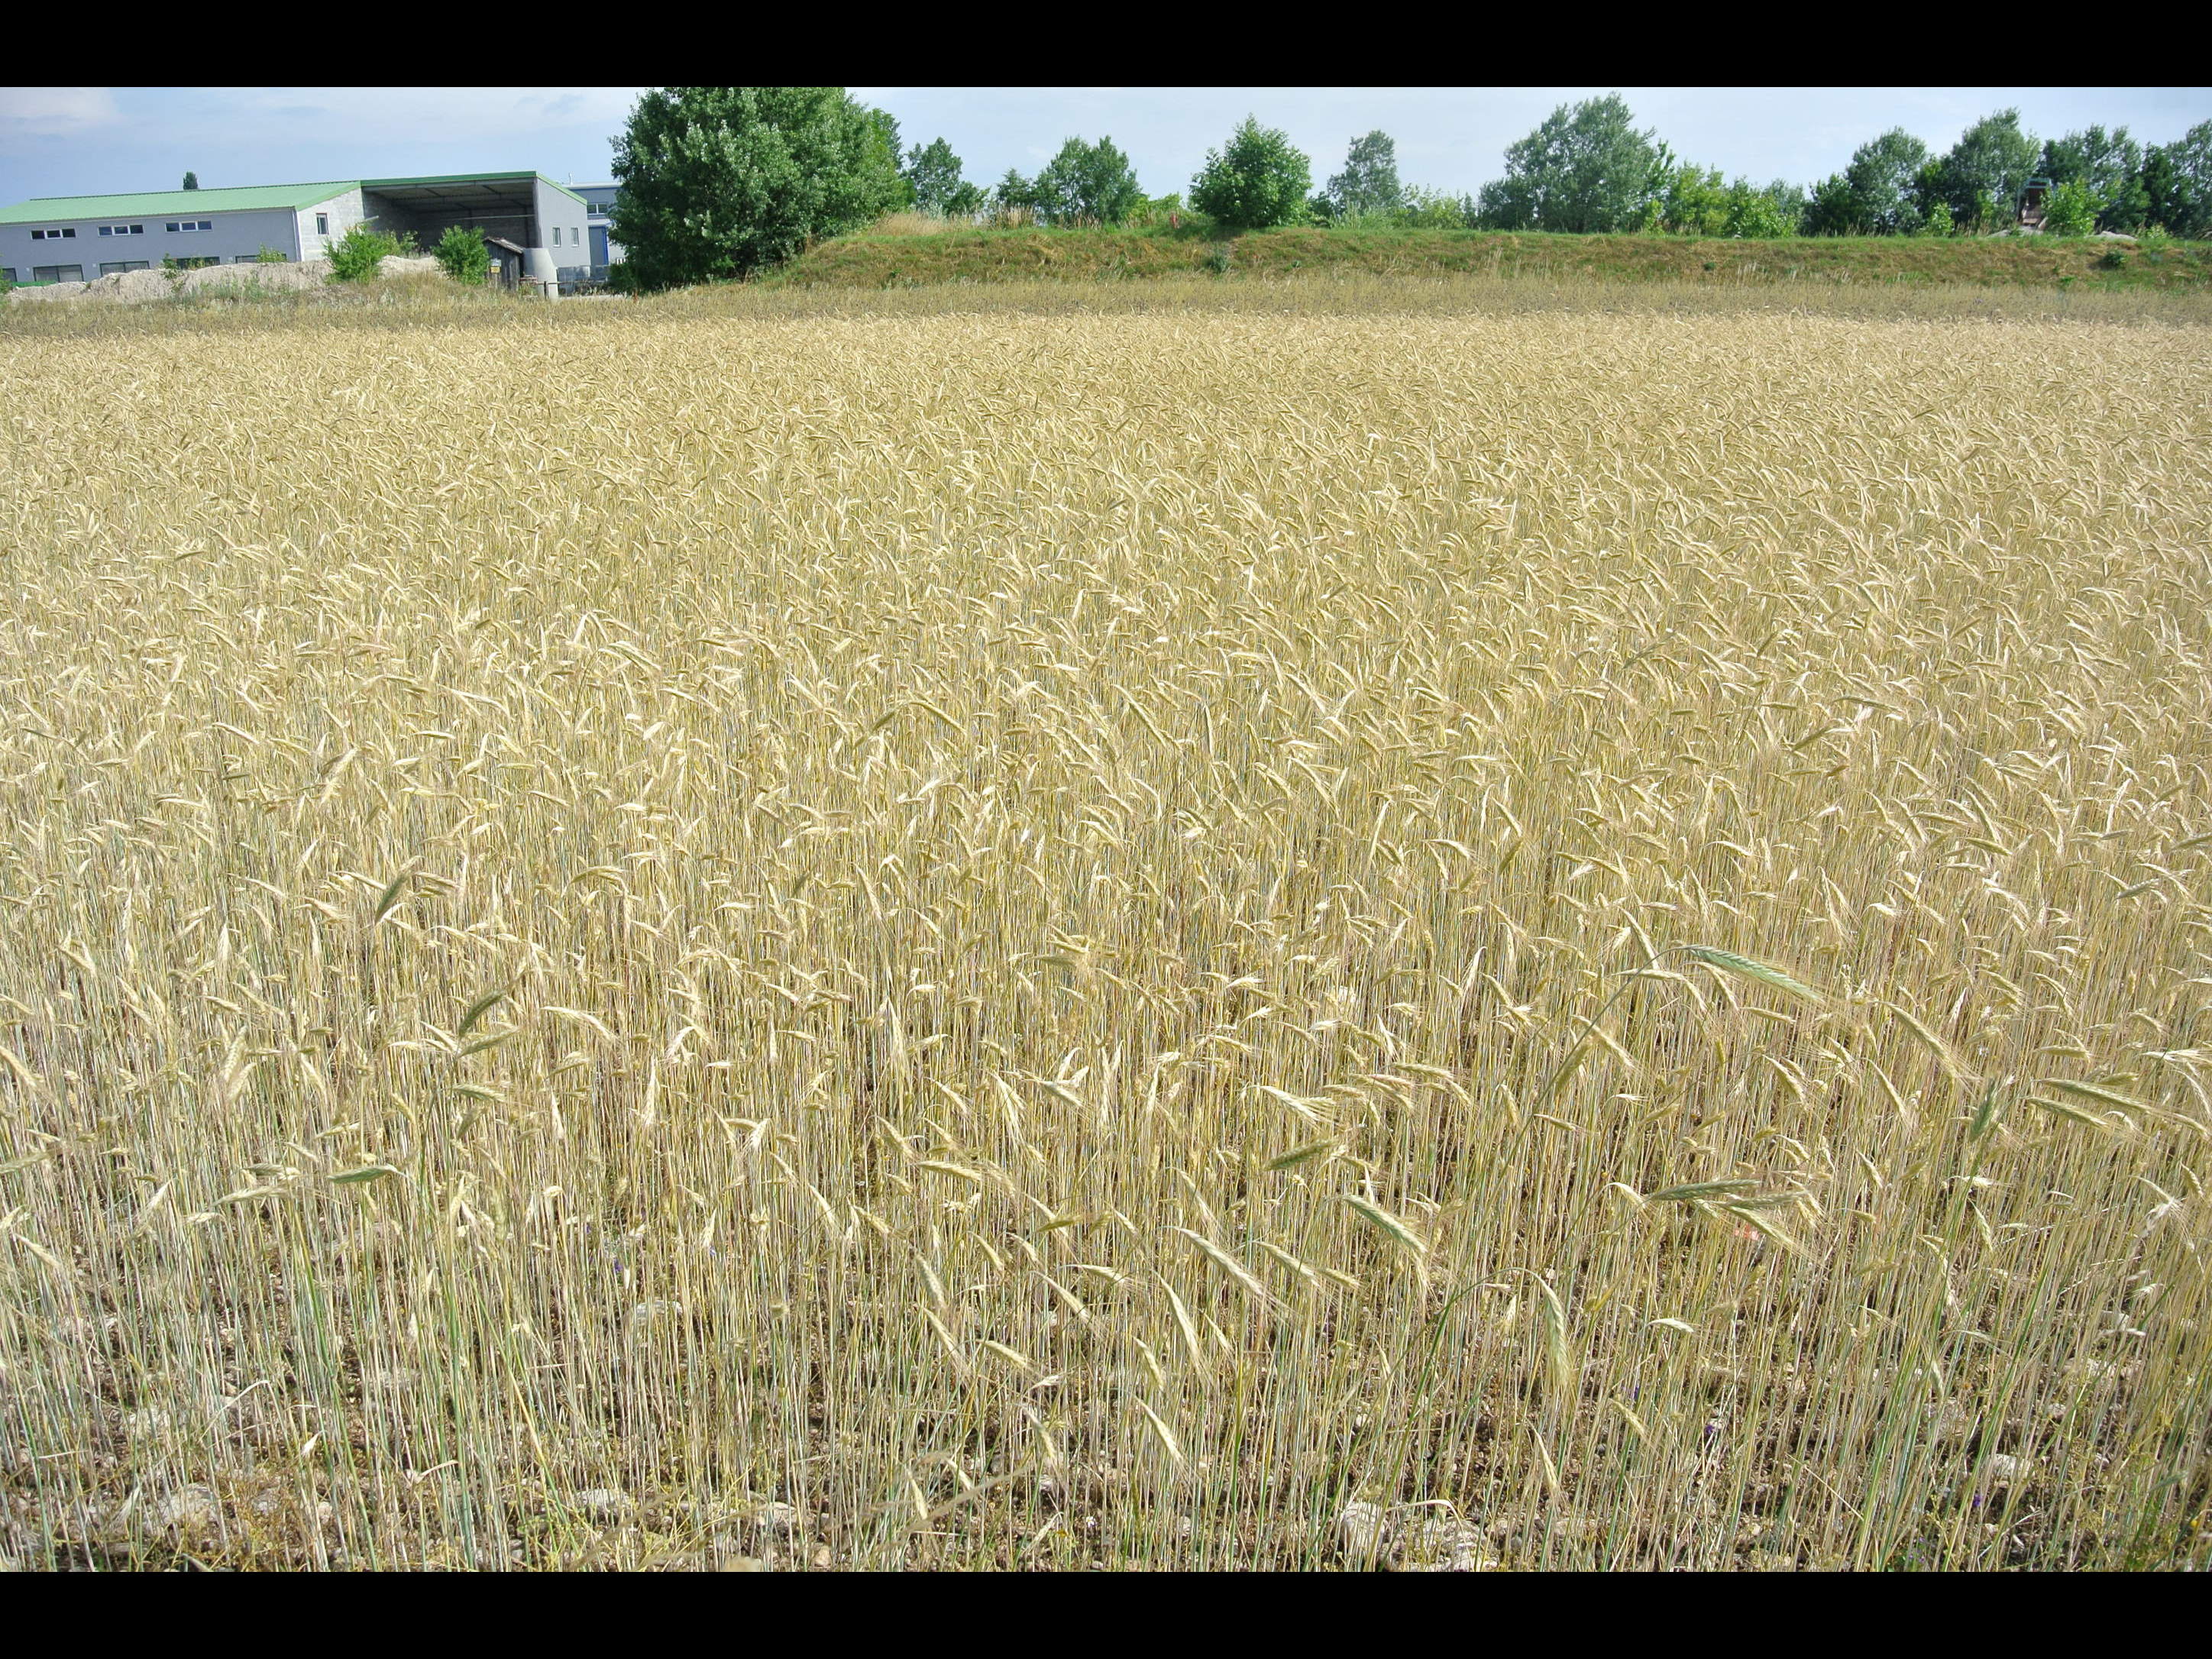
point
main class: Cropland
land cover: Barley
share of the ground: > 75 %
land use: Agriculture (excluding fallow land and kitchen gardens)
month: June
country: AT
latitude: 47.8853
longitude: 16.2223
